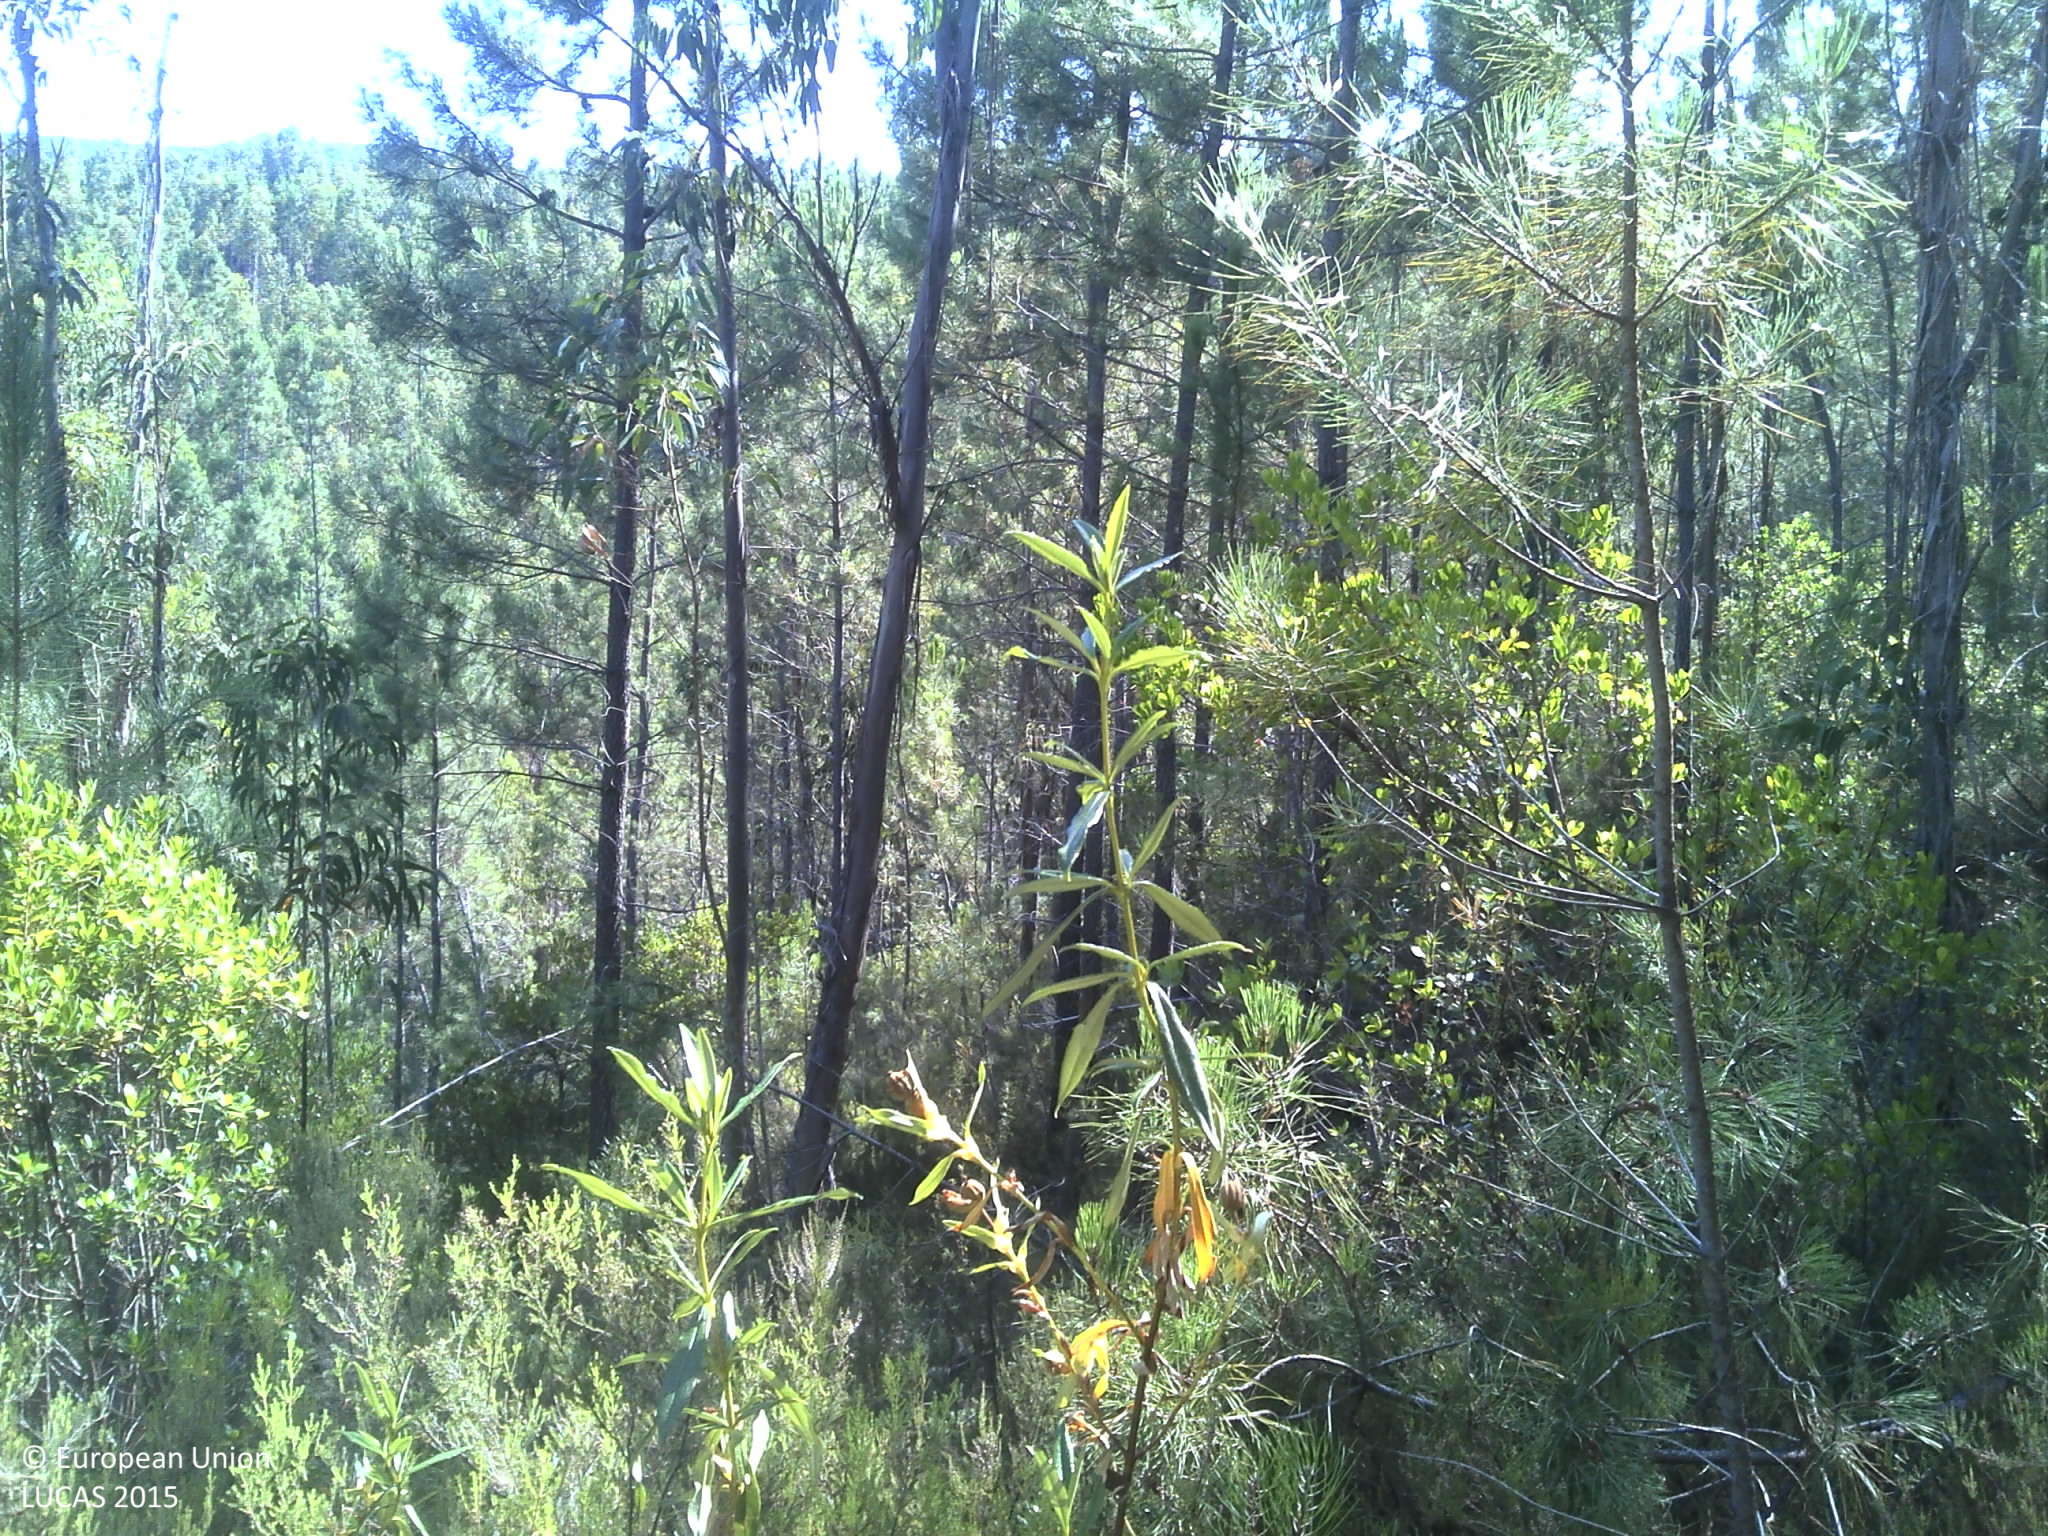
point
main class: Woodland
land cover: Pine dominated coniferous woodland
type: coniferous forest of the mediterranean region
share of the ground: 25 - 50 %
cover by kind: coniferous forest trees 50 %, shrubs 30 %, unconsolidated bare surface 20 %
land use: Forestry
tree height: > 5 m
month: July
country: PT
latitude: 39.9996
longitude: -7.8568
